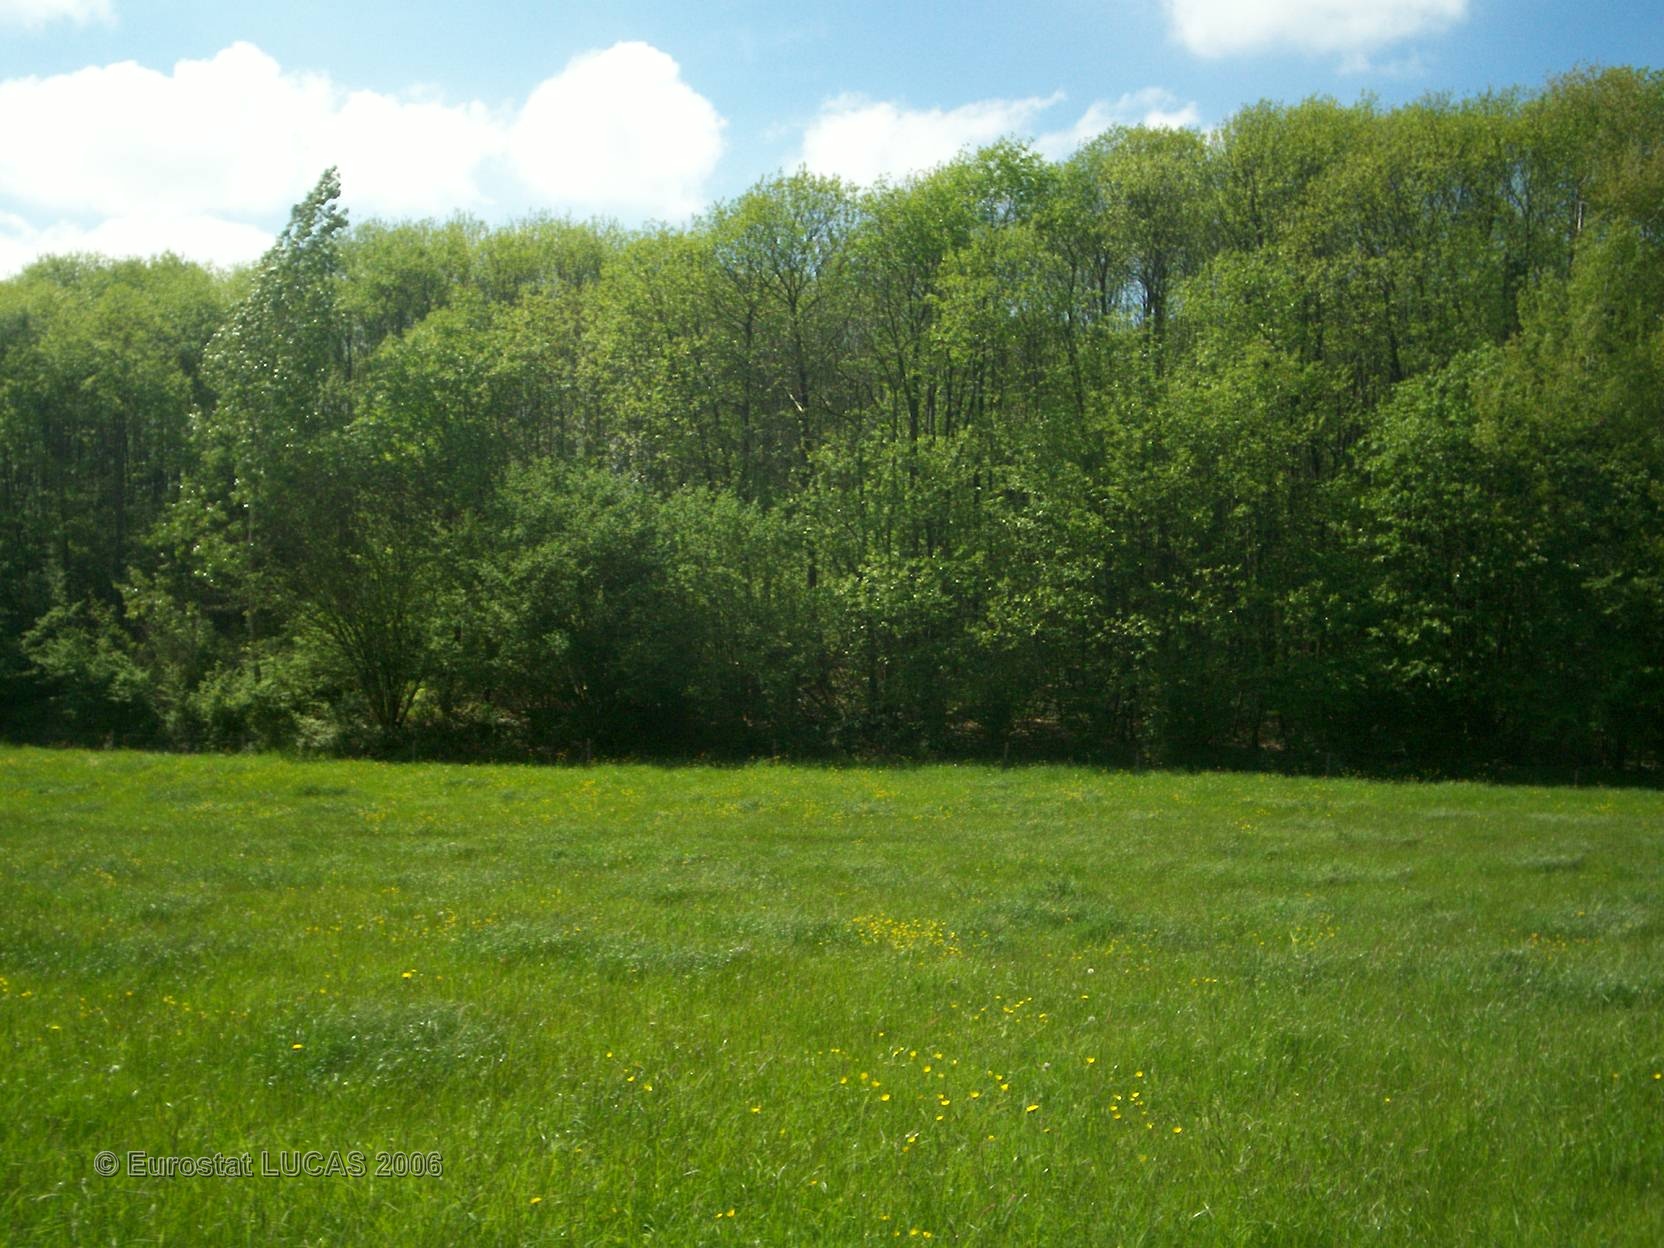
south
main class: Grassland
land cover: Grassland without tree/shrub cover
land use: Agriculture (excluding fallow land and kitchen gardens)
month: May
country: FR
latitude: 46.8332
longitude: -0.8479
